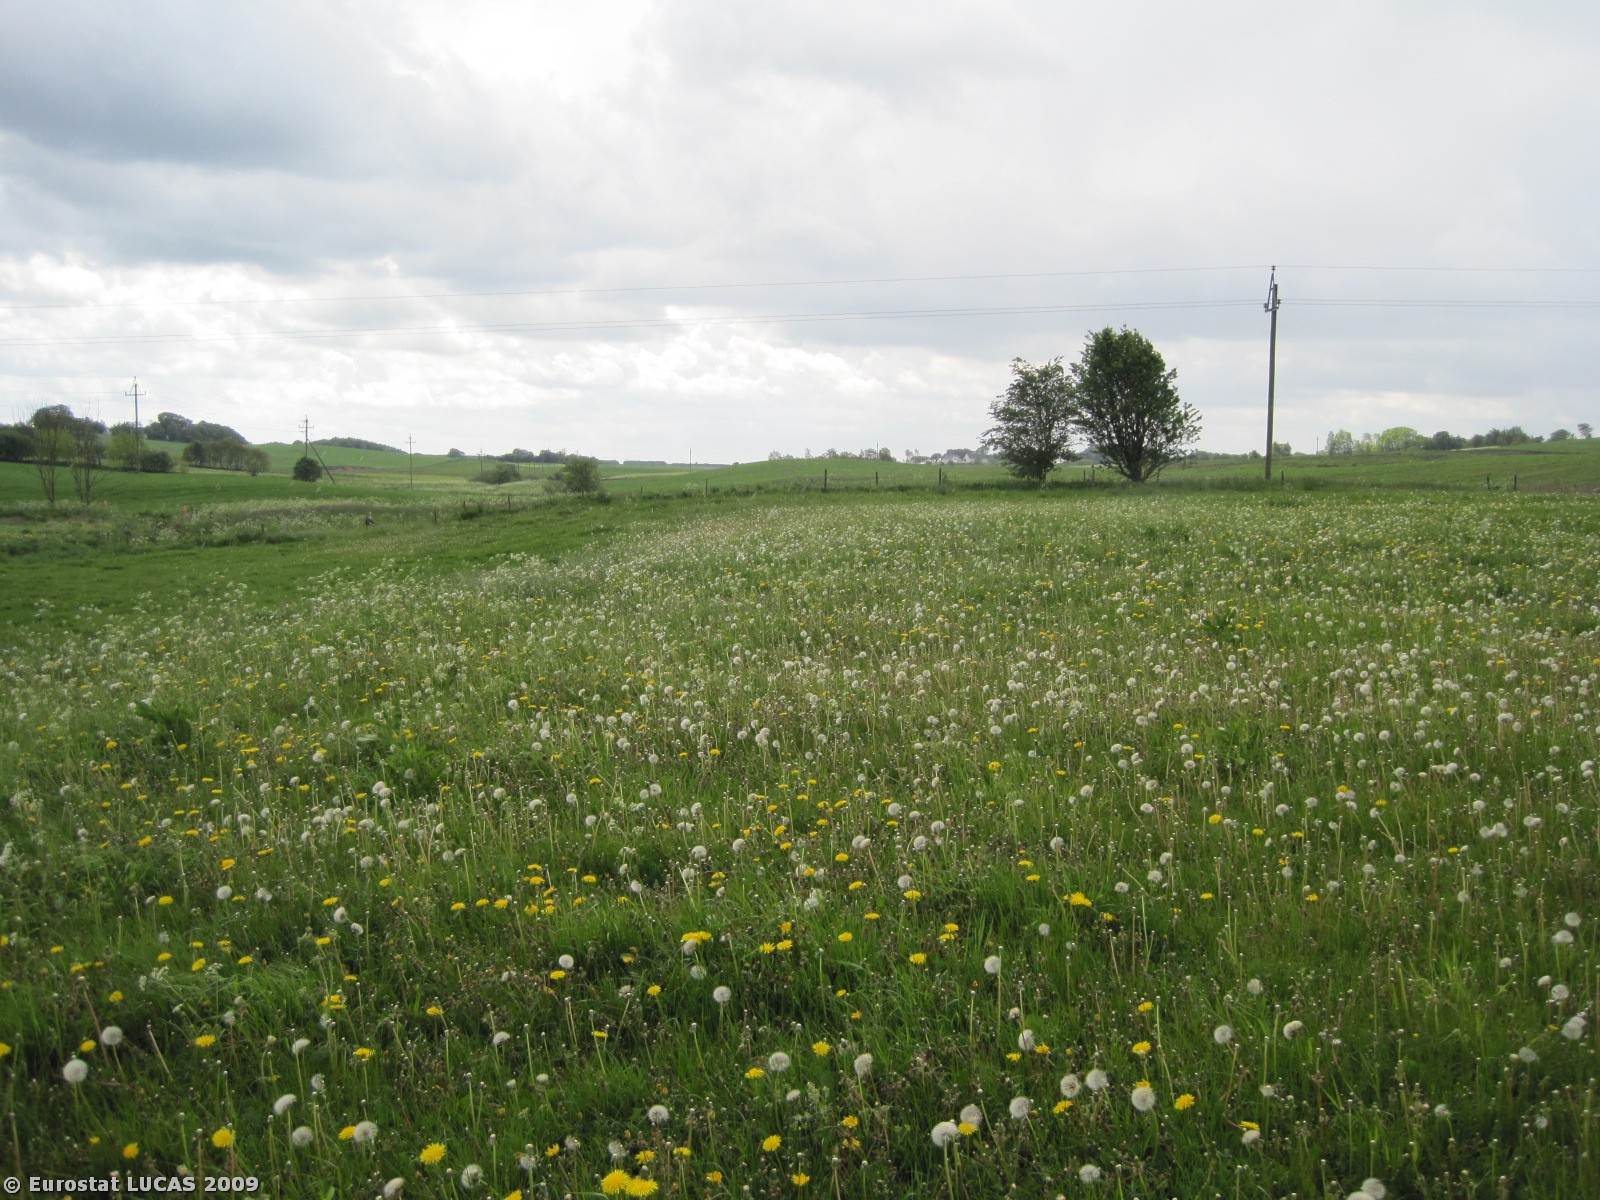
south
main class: Grassland
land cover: Grassland without tree/shrub cover
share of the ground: > 75 %
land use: Agriculture (excluding fallow land and kitchen gardens)
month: May
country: DK
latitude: 56.7268
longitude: 9.7552
